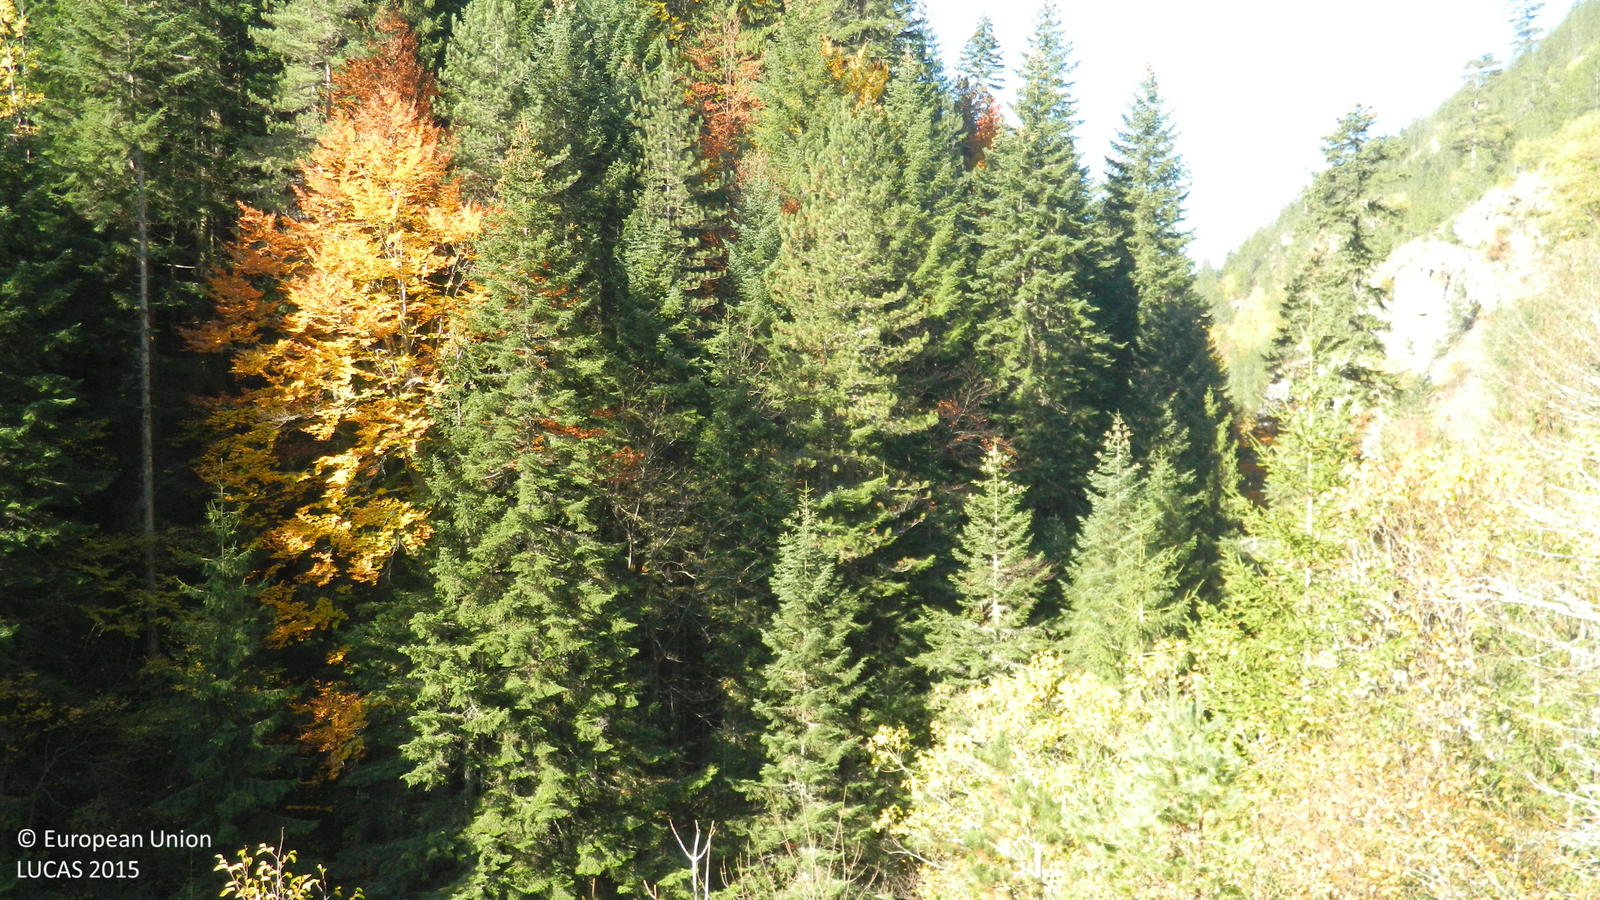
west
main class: Woodland
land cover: Spruce dominated coniferous woodland
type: alpine coniferous forest
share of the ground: > 75 %
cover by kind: coniferous forest trees 100 %
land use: Forestry
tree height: > 5 m
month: October
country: BG
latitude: 41.6467
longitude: 24.4605
